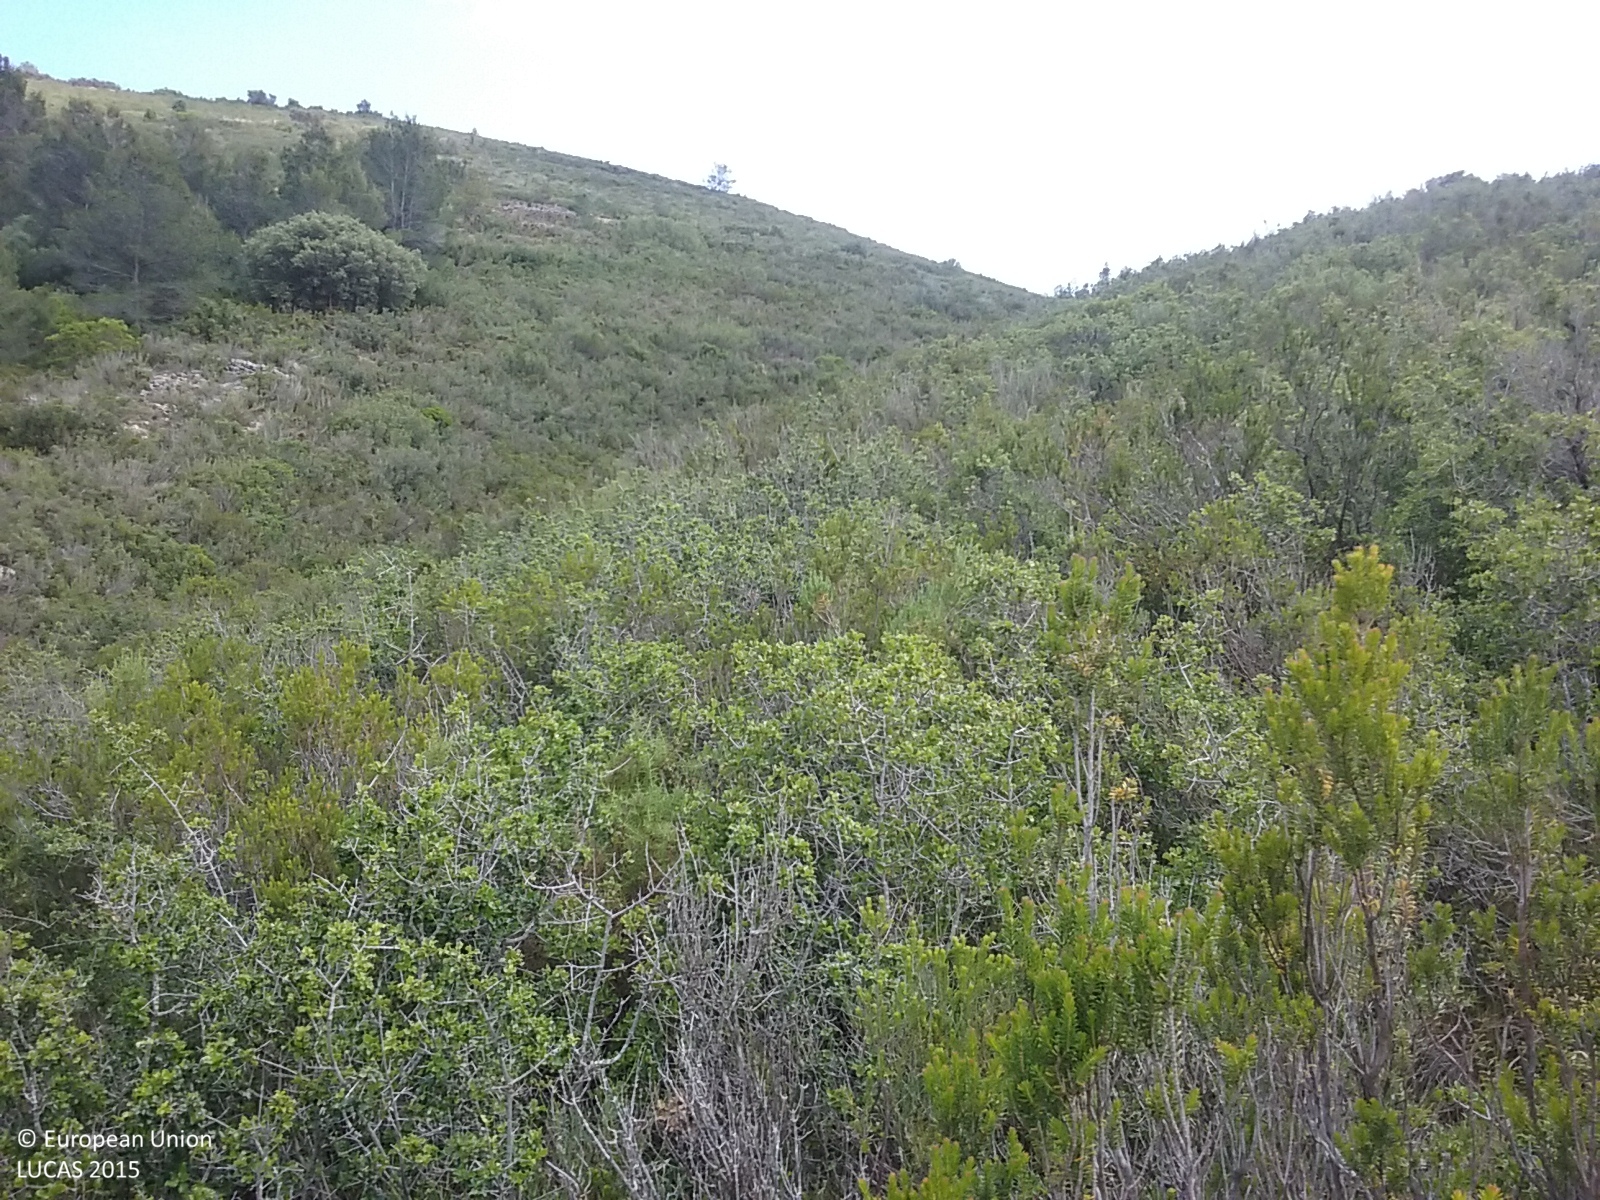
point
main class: Shrubland
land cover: Shrubland with sparse tree cover
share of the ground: > 75 %
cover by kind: shrubs 90 %, coniferous forest trees 5 %, herbaceous plants 5 %
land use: Semi-natural and natural areas not in use
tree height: < 5 m
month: May
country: ES
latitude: 40.2557
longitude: 0.0856
